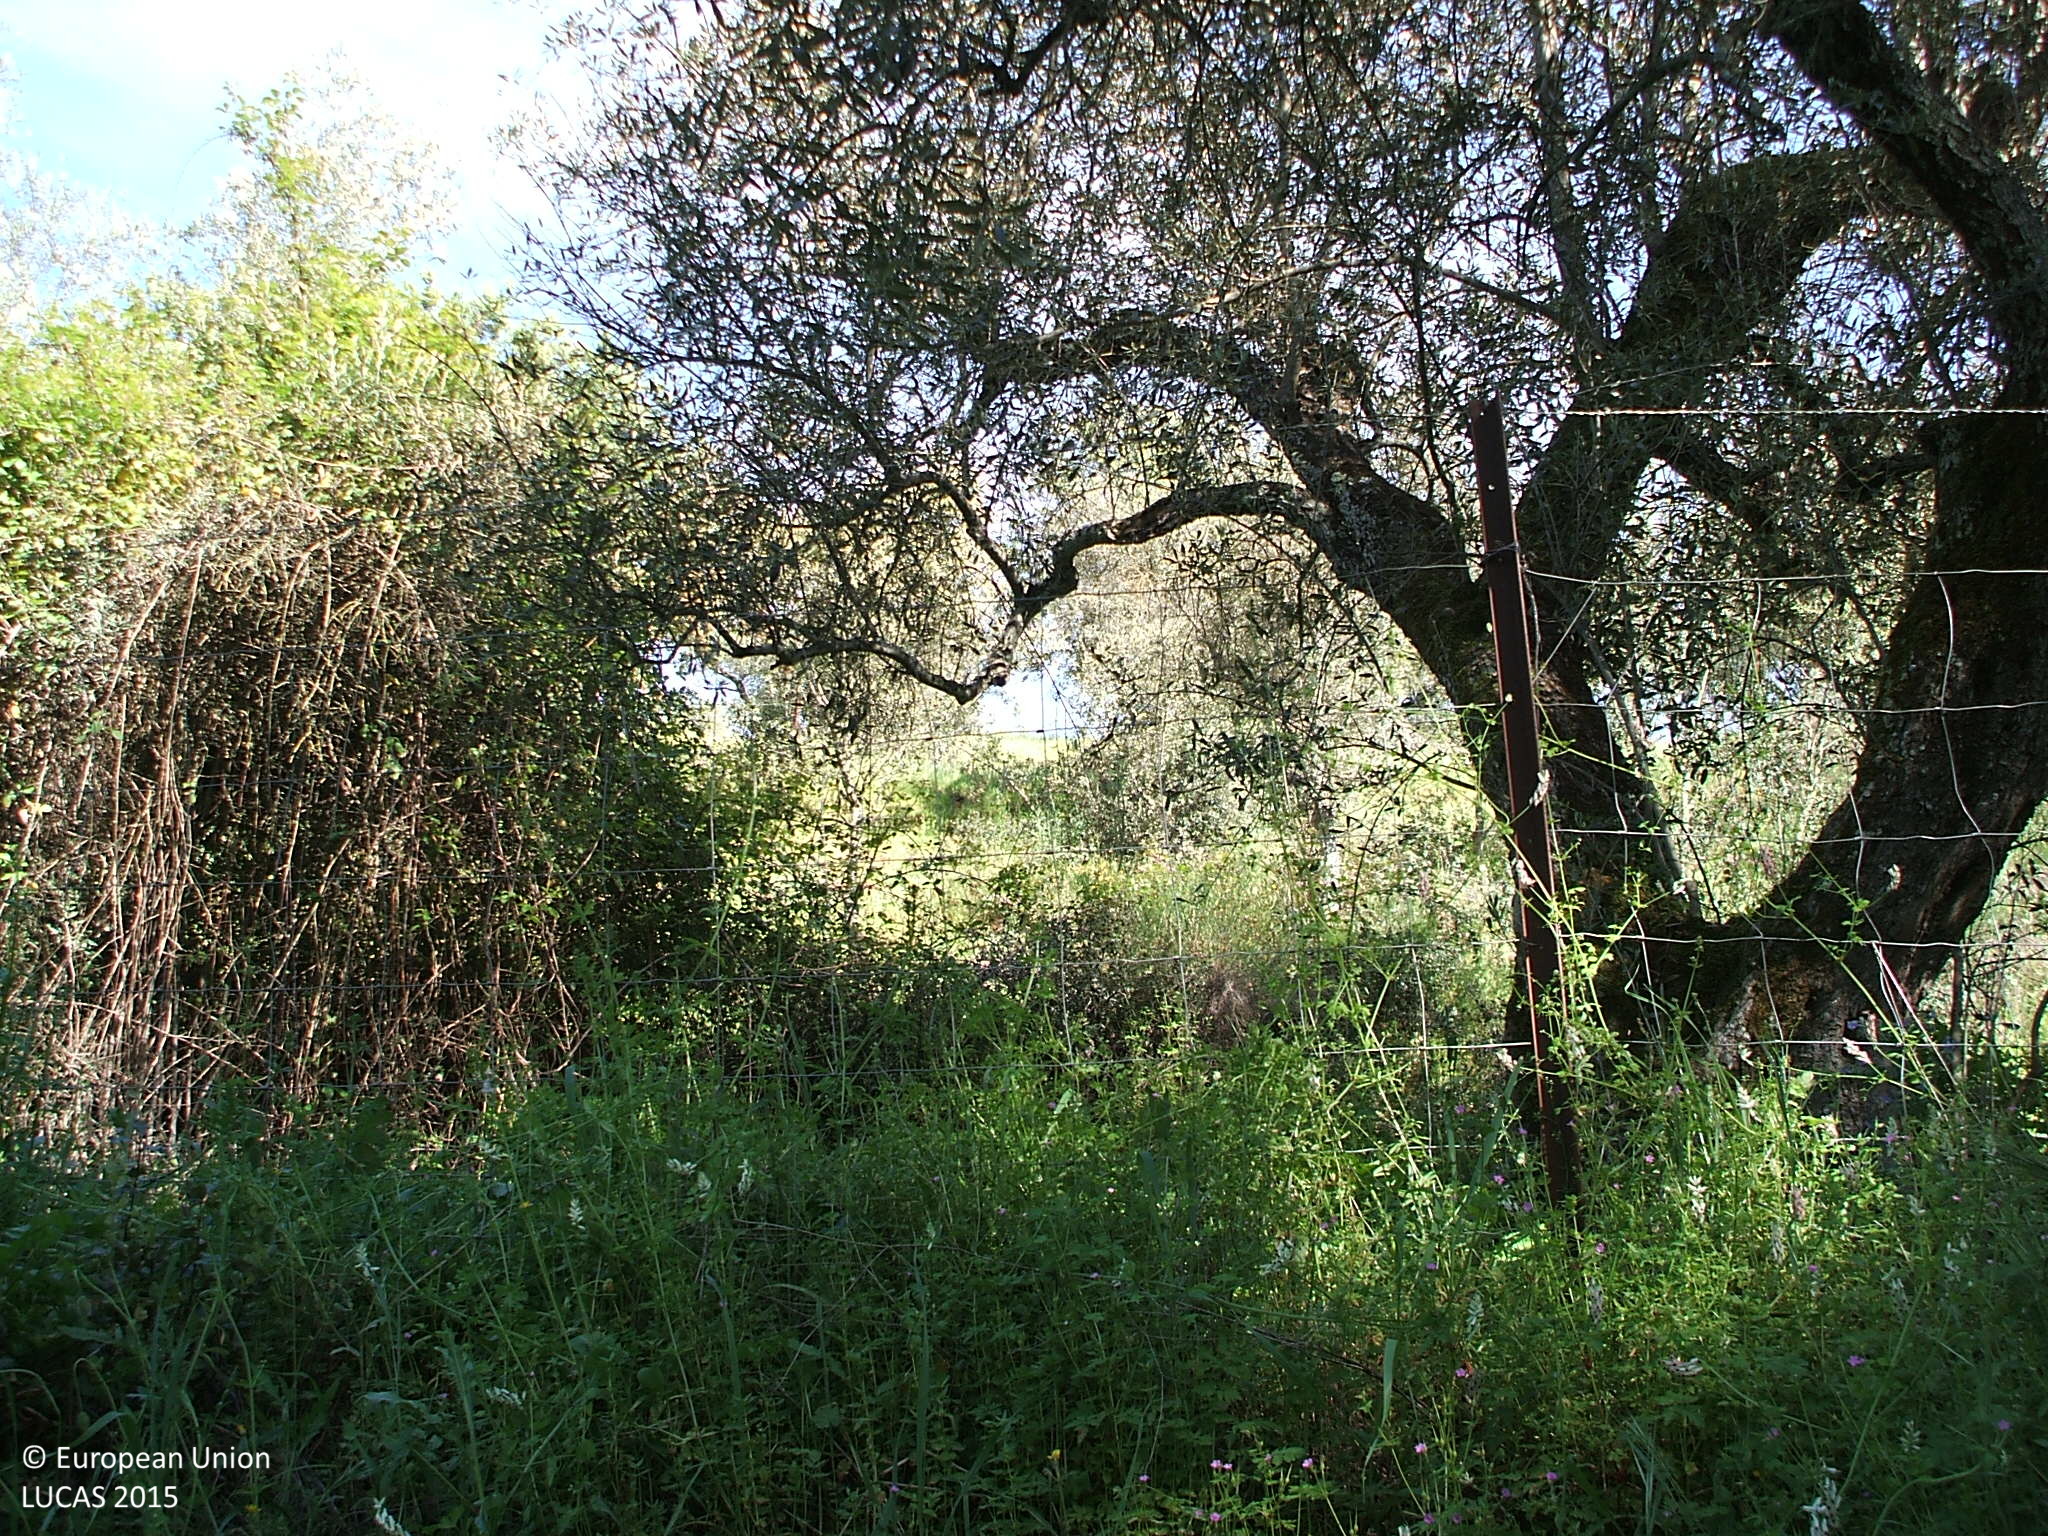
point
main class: Cropland
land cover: Olive groves
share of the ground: 25 - 50 %
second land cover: Grassland without tree/shrub cover
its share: > 75 %
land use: Agriculture (excluding fallow land and kitchen gardens)
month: April
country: ES
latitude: 38.0342
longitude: -5.7195
